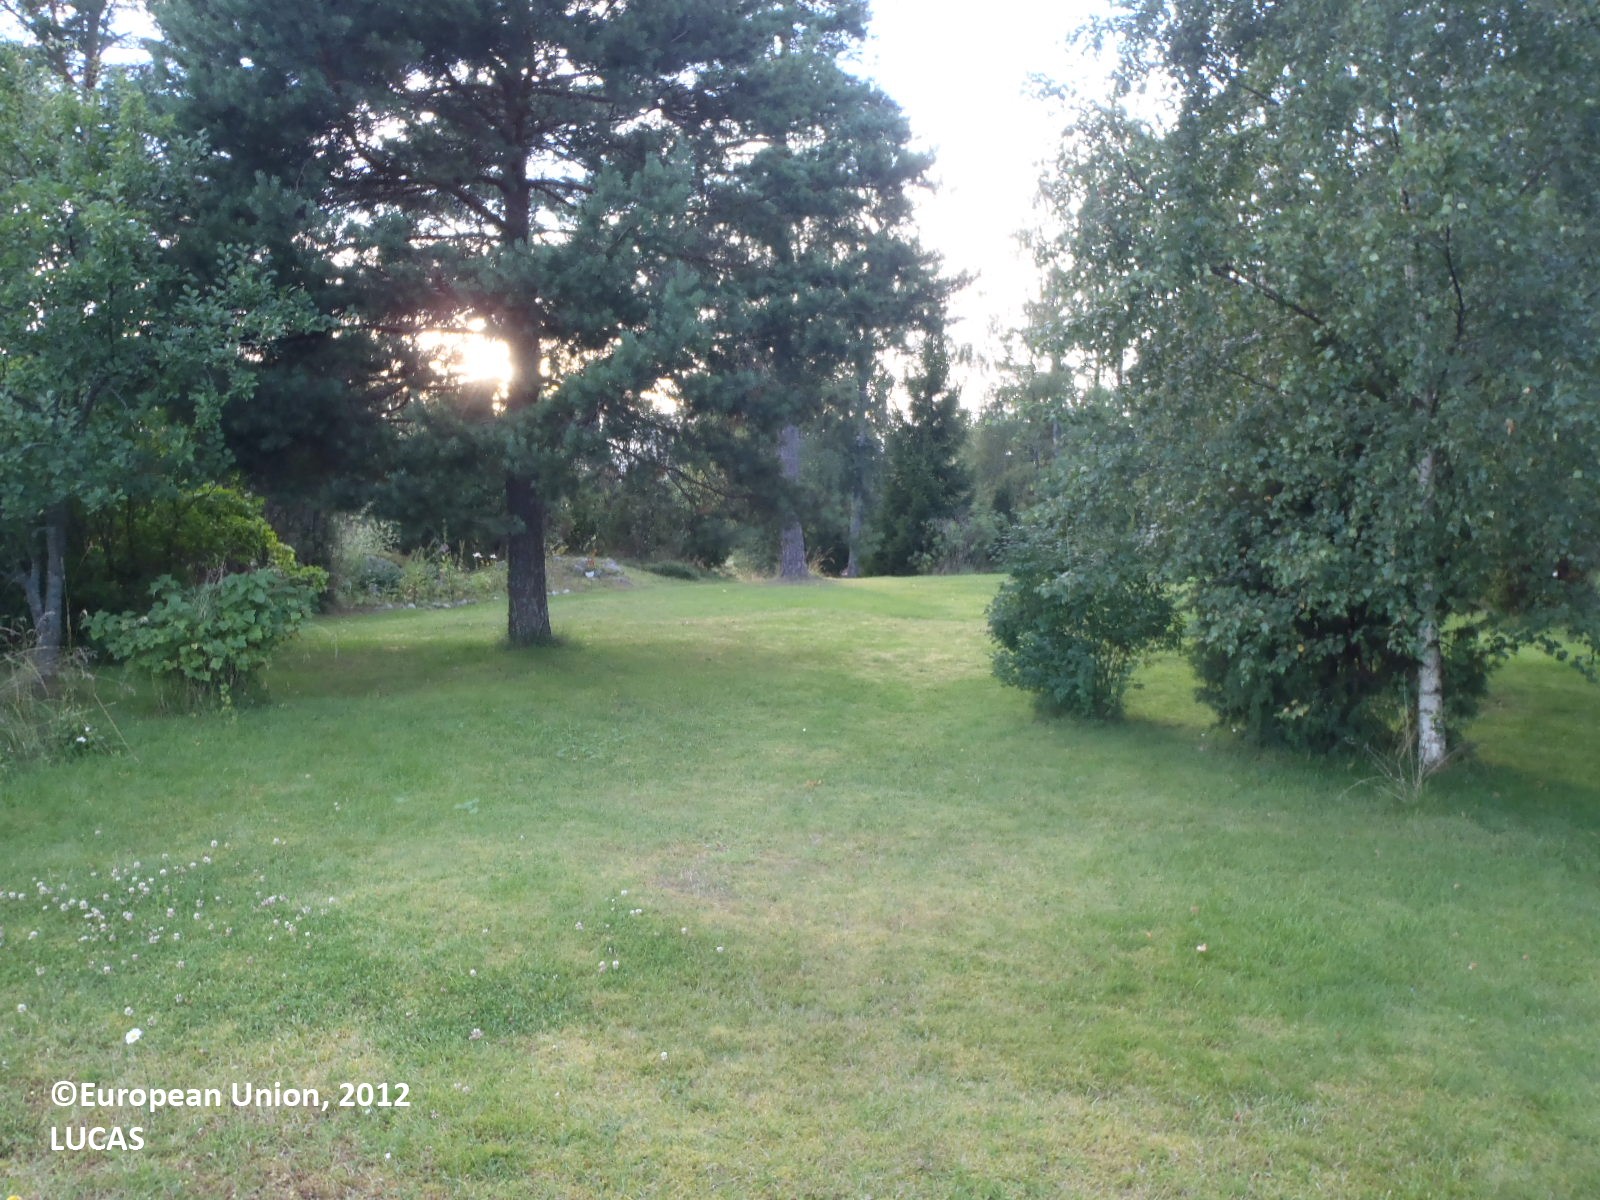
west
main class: Cropland
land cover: Oats
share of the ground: > 75 %
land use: Agriculture (excluding fallow land and kitchen gardens)
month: August
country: FI
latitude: 60.2133
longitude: 22.2131
